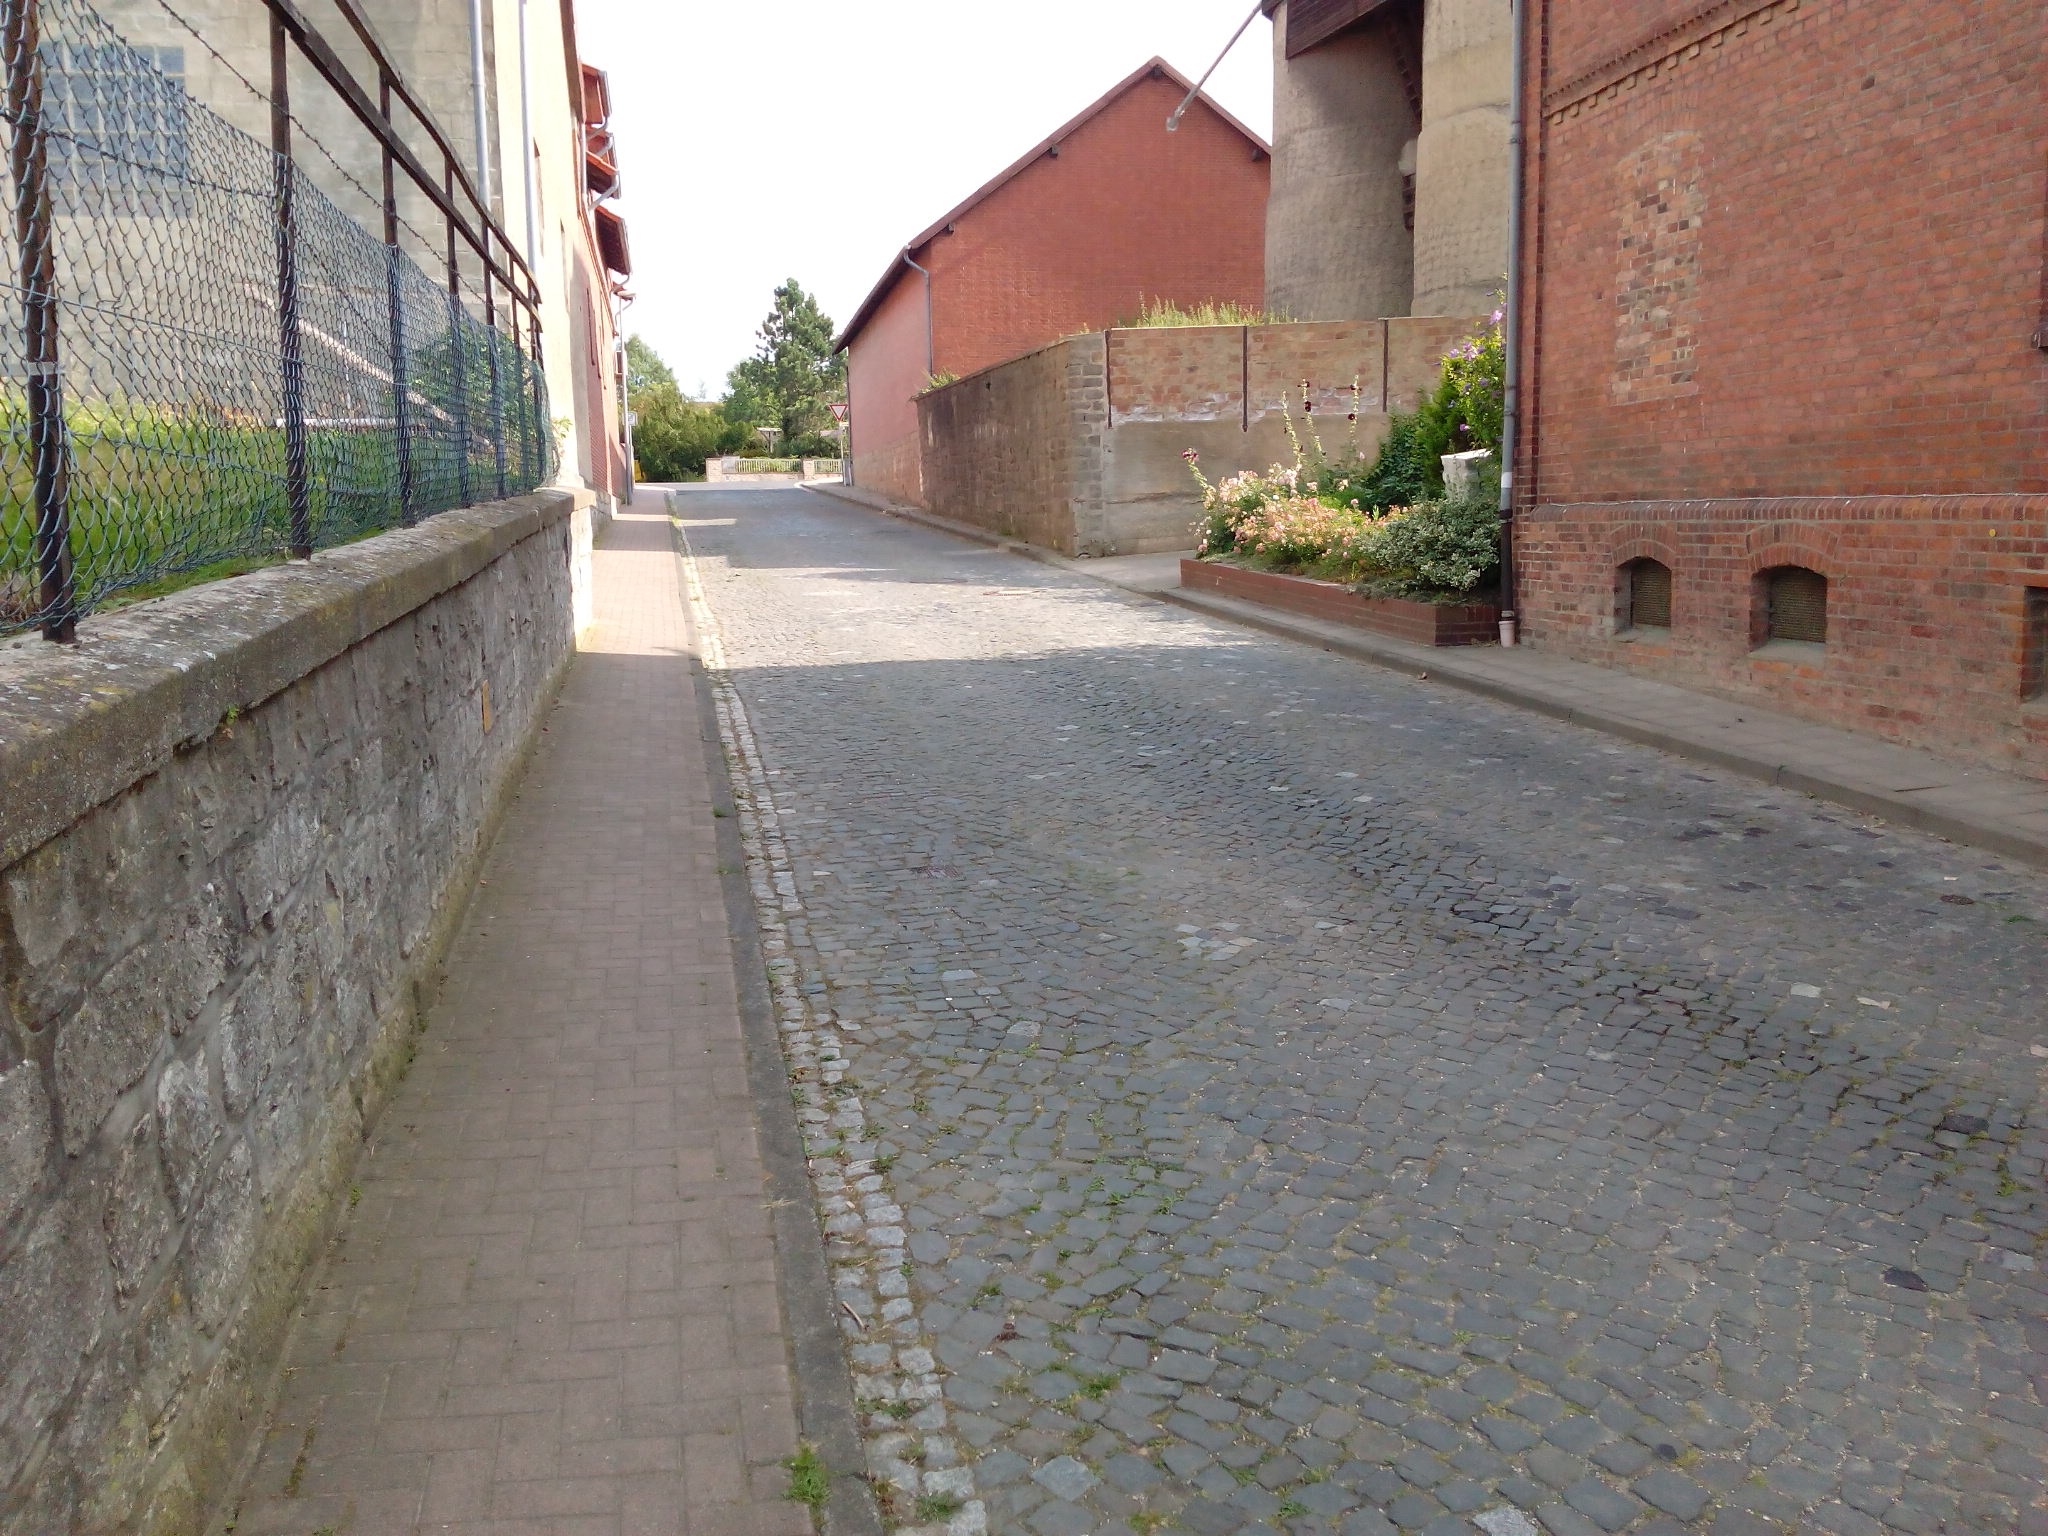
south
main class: Grassland
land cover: Grassland with sparse tree/shrub cover
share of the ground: > 75 %
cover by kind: herbaceous plants 95 %, broadleaved forest trees 5 %
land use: Agriculture (excluding fallow land and kitchen gardens)
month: August
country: DE
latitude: 52.1977
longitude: 9.8976
